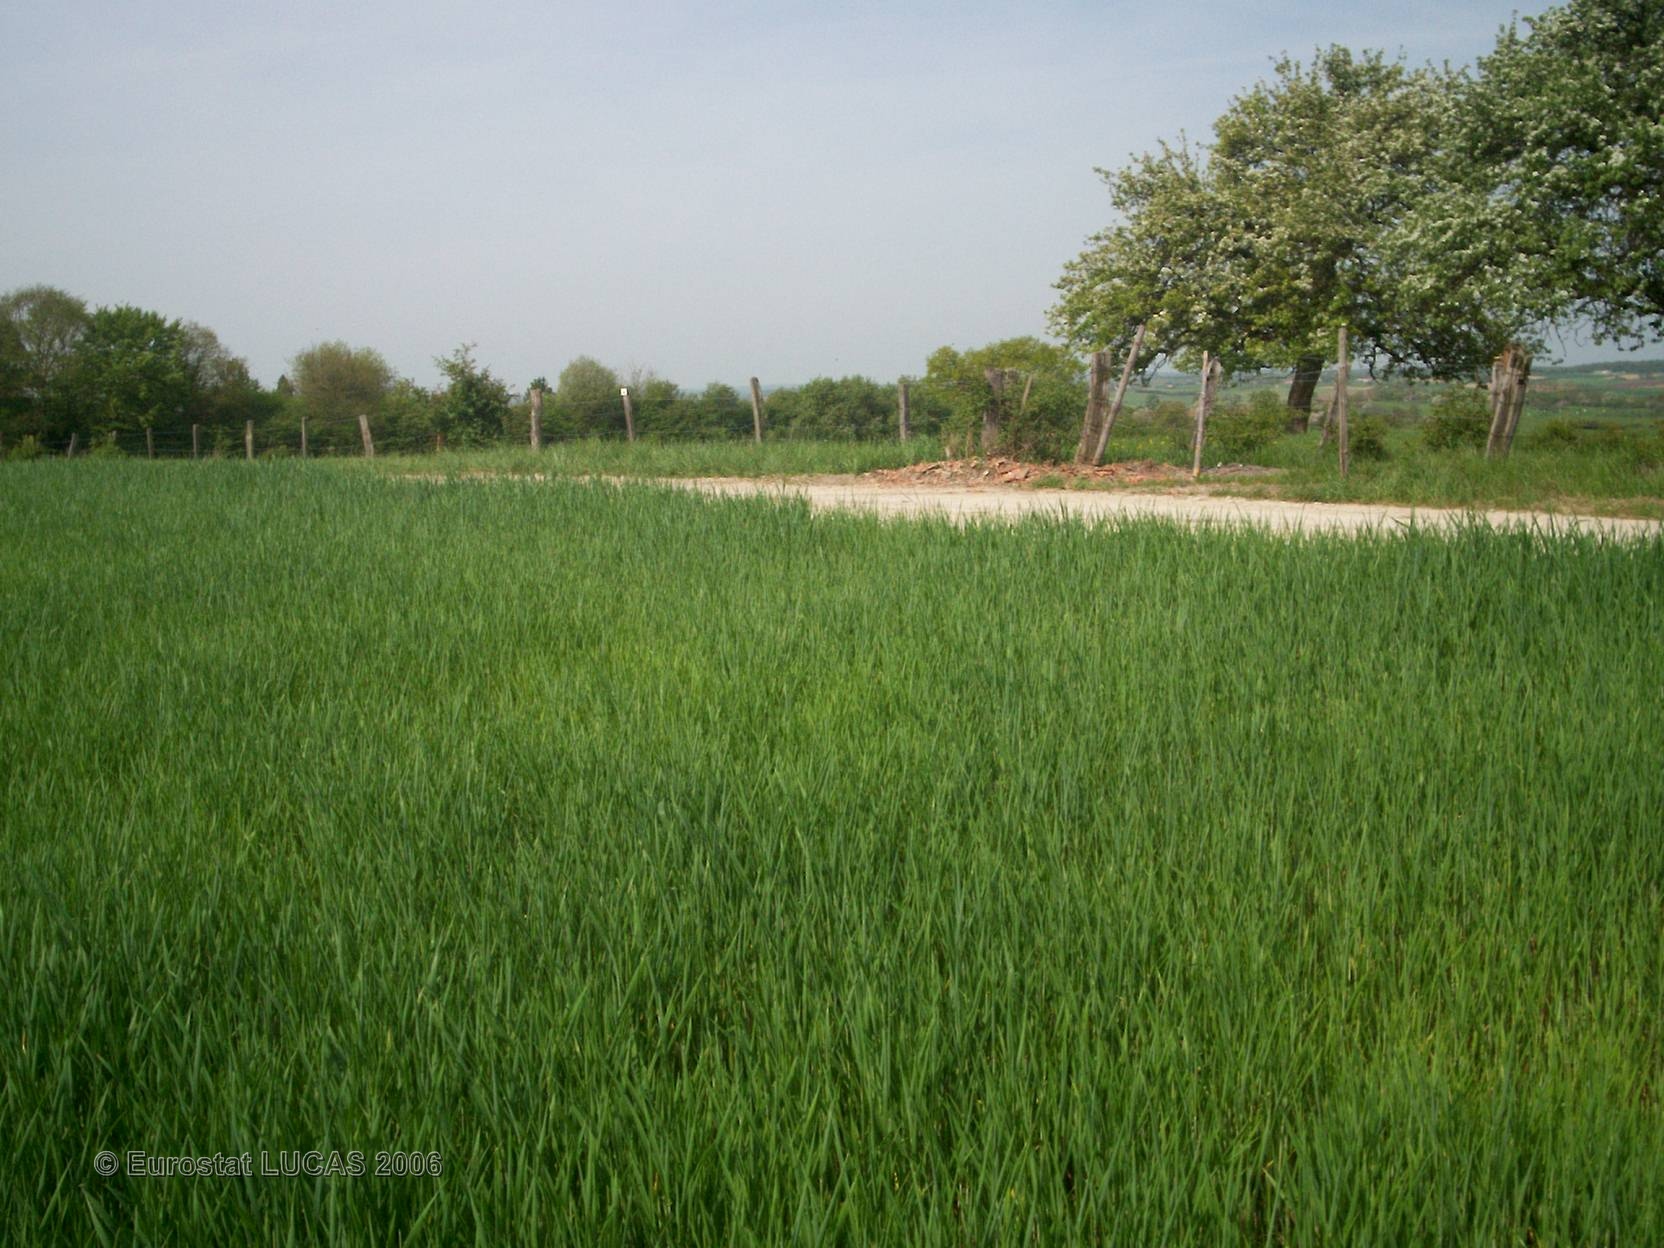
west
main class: Cropland
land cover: Barley
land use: Agriculture (excluding fallow land and kitchen gardens)
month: May
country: FR
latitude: 48.9205
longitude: 6.9845
